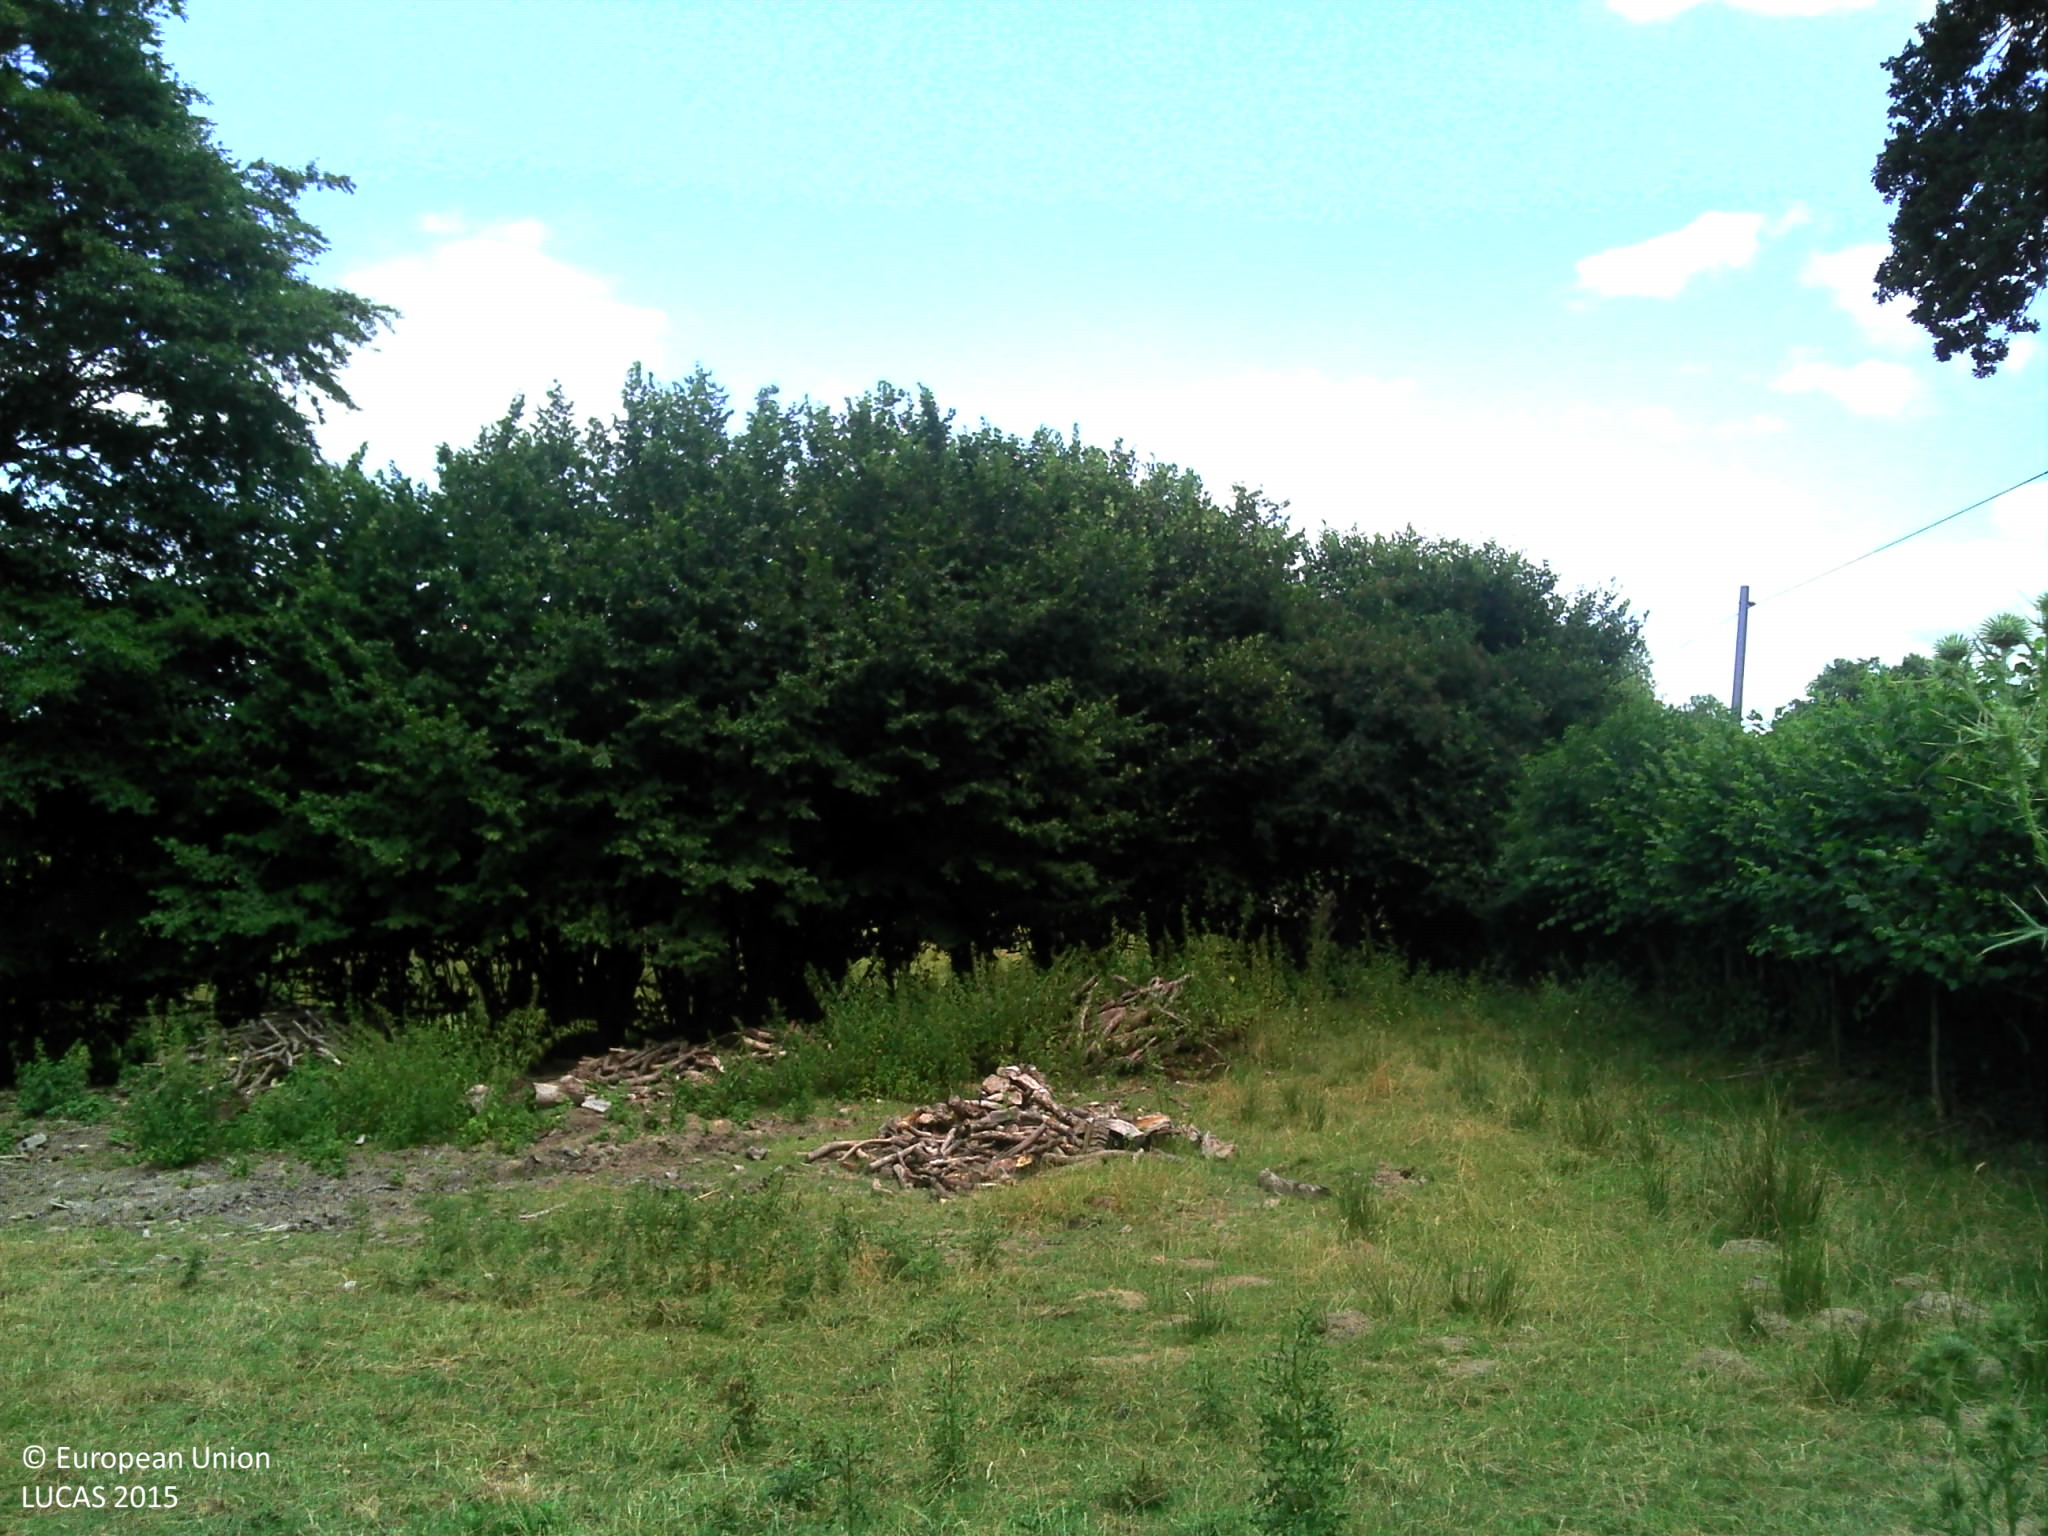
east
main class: Grassland
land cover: Grassland without tree/shrub cover
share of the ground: > 75 %
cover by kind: herbaceous plants 95 %, shrubs 5 %
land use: Agriculture (excluding fallow land and kitchen gardens)
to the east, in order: Grassland without tree/shrub cover; Spontaneously vegetated surfaces; Abandoned hedges; Fences; Grassland without tree/shrub cover; Fences; Electric lines; Grass margins; Paved roads, cycling and walking lanes; Grass margins; Ditches and canals; Managed hedges; Fences; Grassland without tree/shrub cover; Fences; Broadleaved woodland; Fences; Grassland without tree/shrub cover; Fences; Spontaneously vegetated surfaces; Fences; Grassland without tree/shrub cover
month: July
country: FR
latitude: 46.4117
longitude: 3.0115
